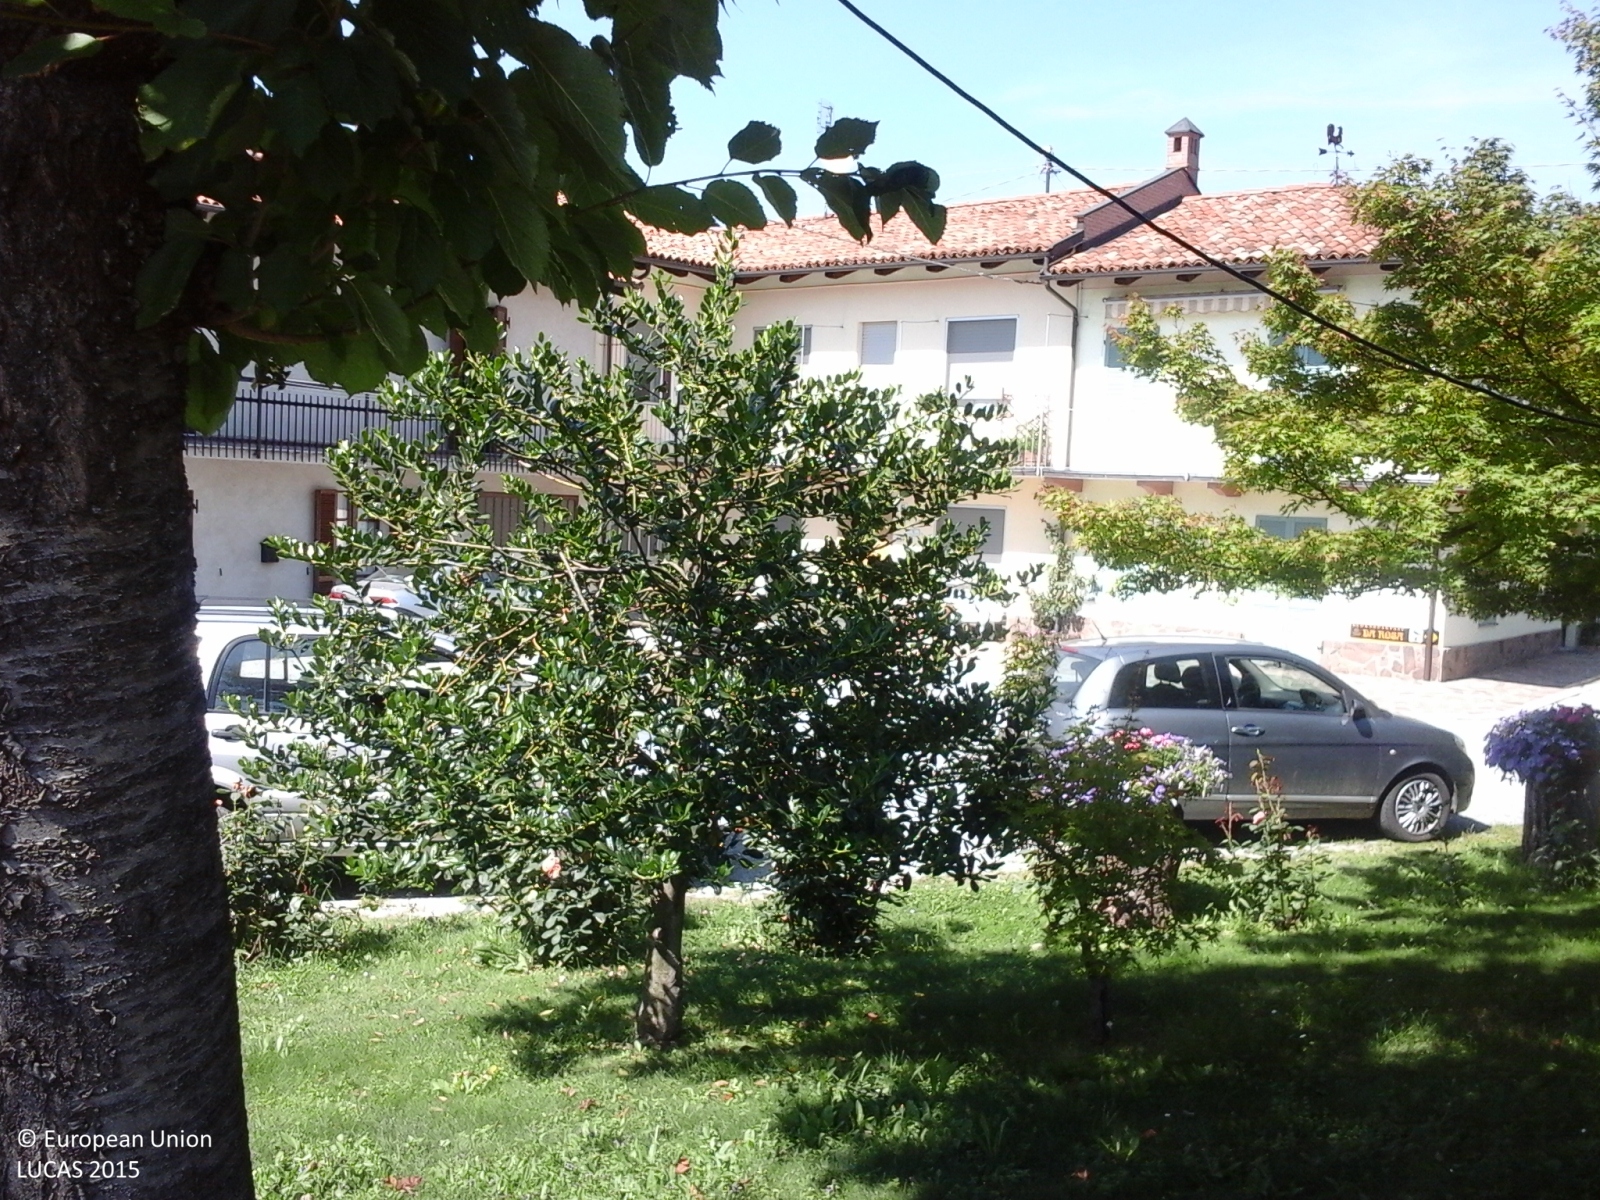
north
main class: Woodland
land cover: Broadleaved woodland
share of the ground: > 75 %
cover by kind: broadleaved forest trees 95 %, herbaceous plants 5 %
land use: Residential
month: June
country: IT
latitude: 44.6944
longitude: 8.1236
